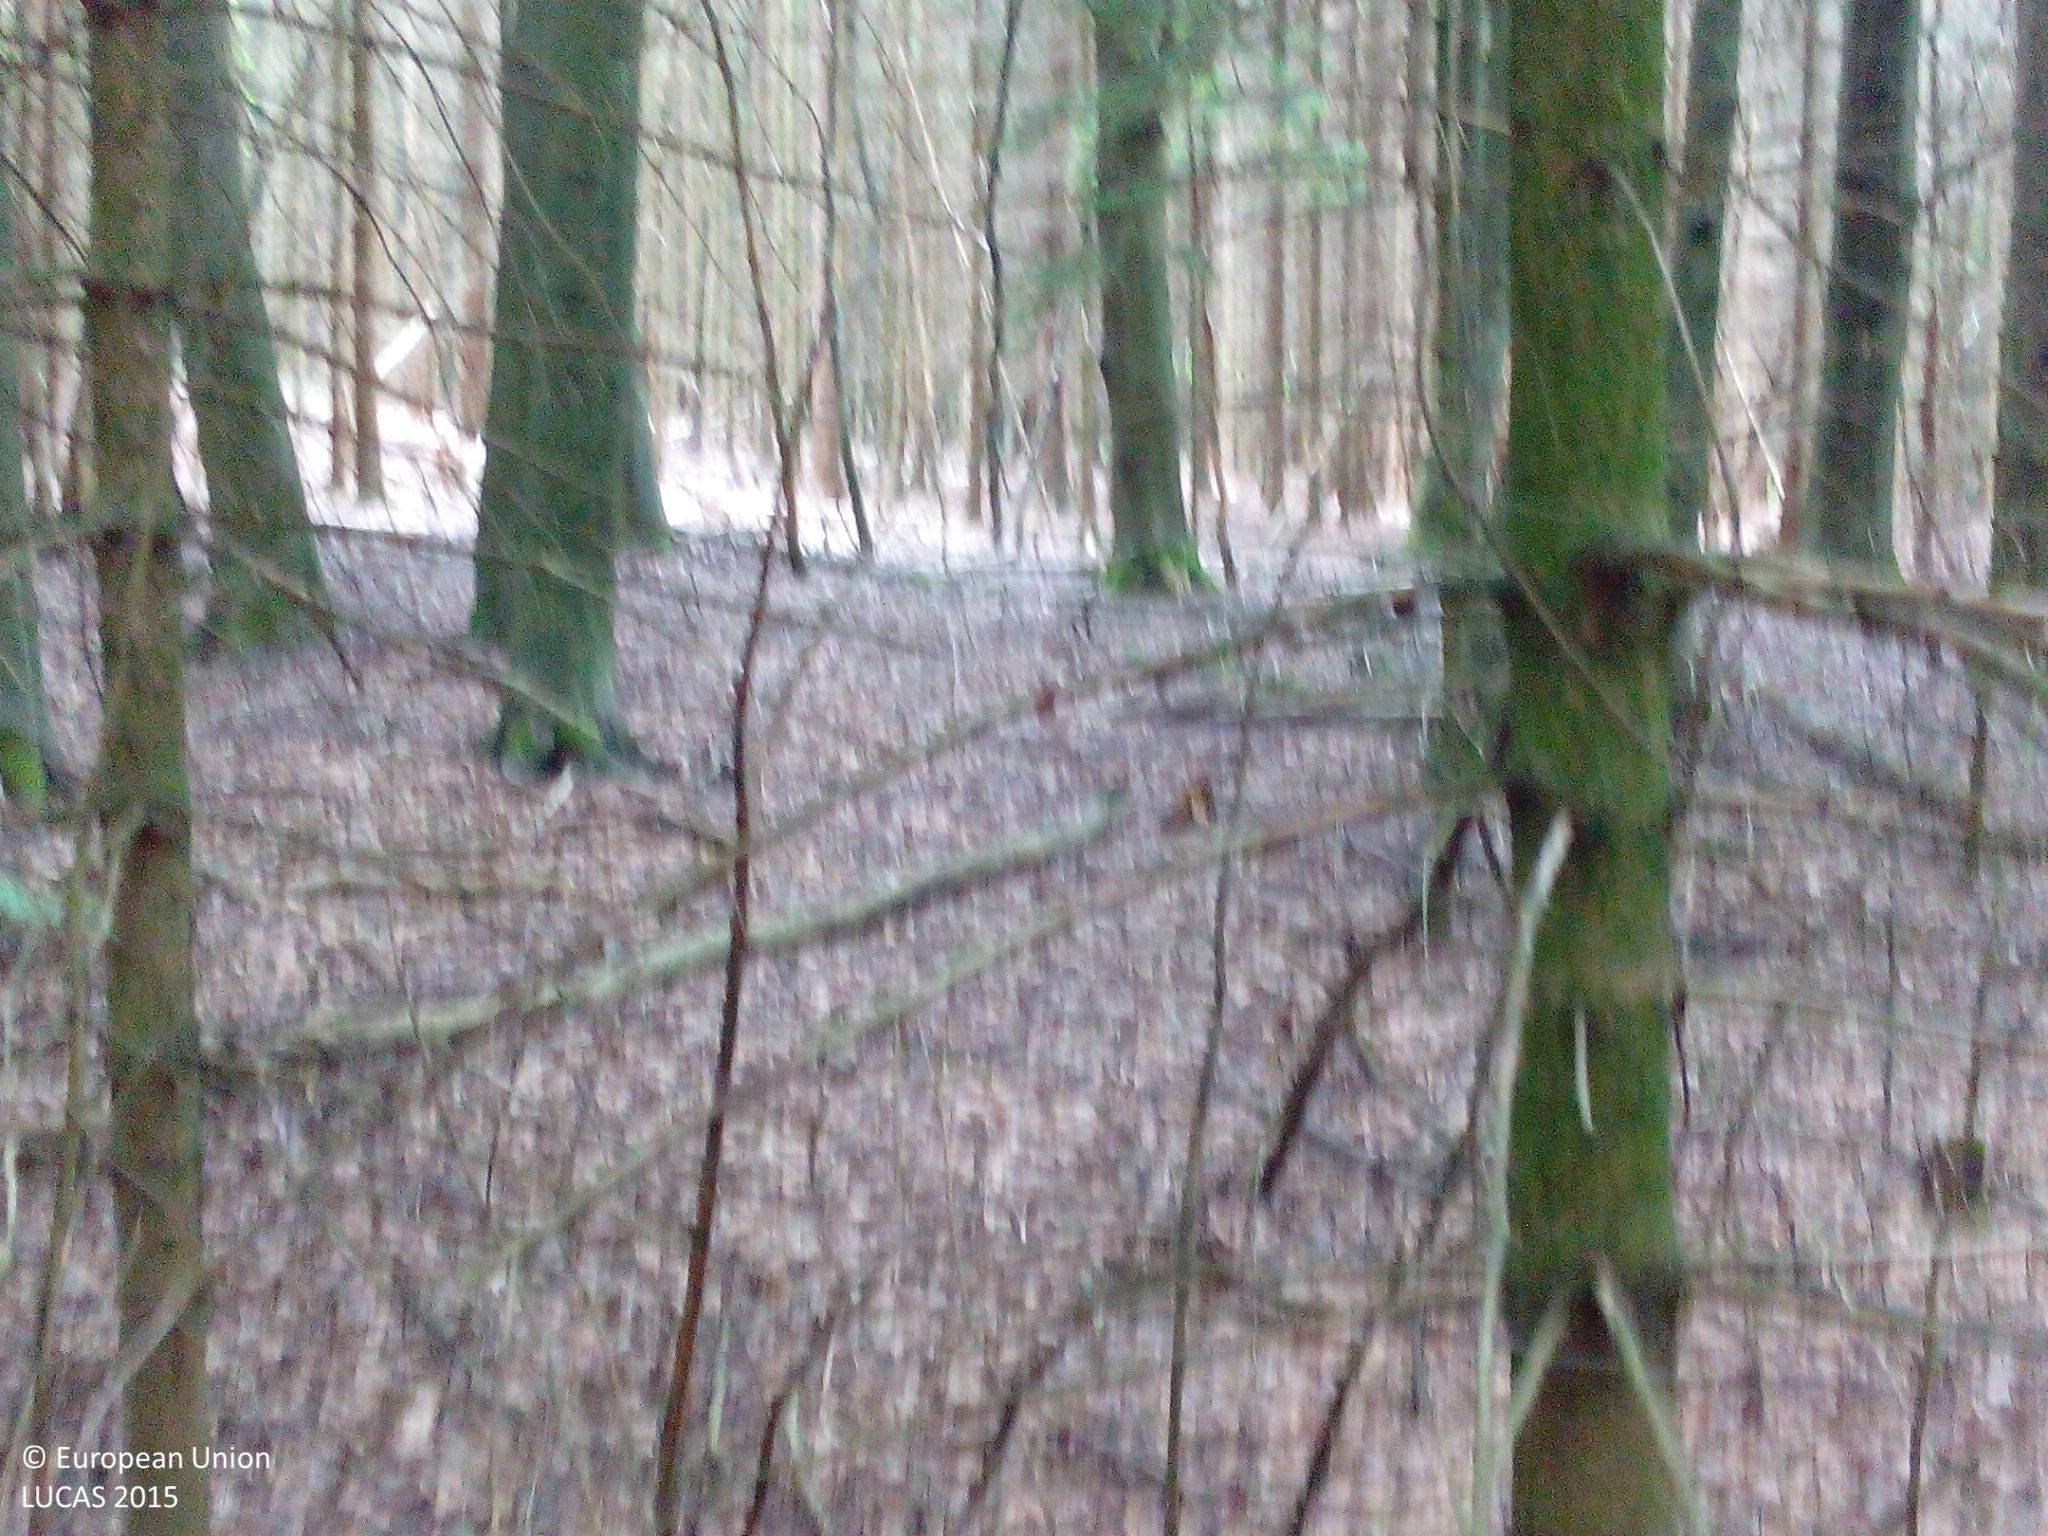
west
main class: Woodland
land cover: Spruce dominated mixed woodland
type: hemiboreal forest and nemoral coniferous forest and mixed broadleaved-coniferous forest
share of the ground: > 75 %
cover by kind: coniferous forest trees 70 %, broadleaved forest trees 30 %
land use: Forestry
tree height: > 5 m
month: July
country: DE
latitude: 50.5438
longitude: 9.9295
